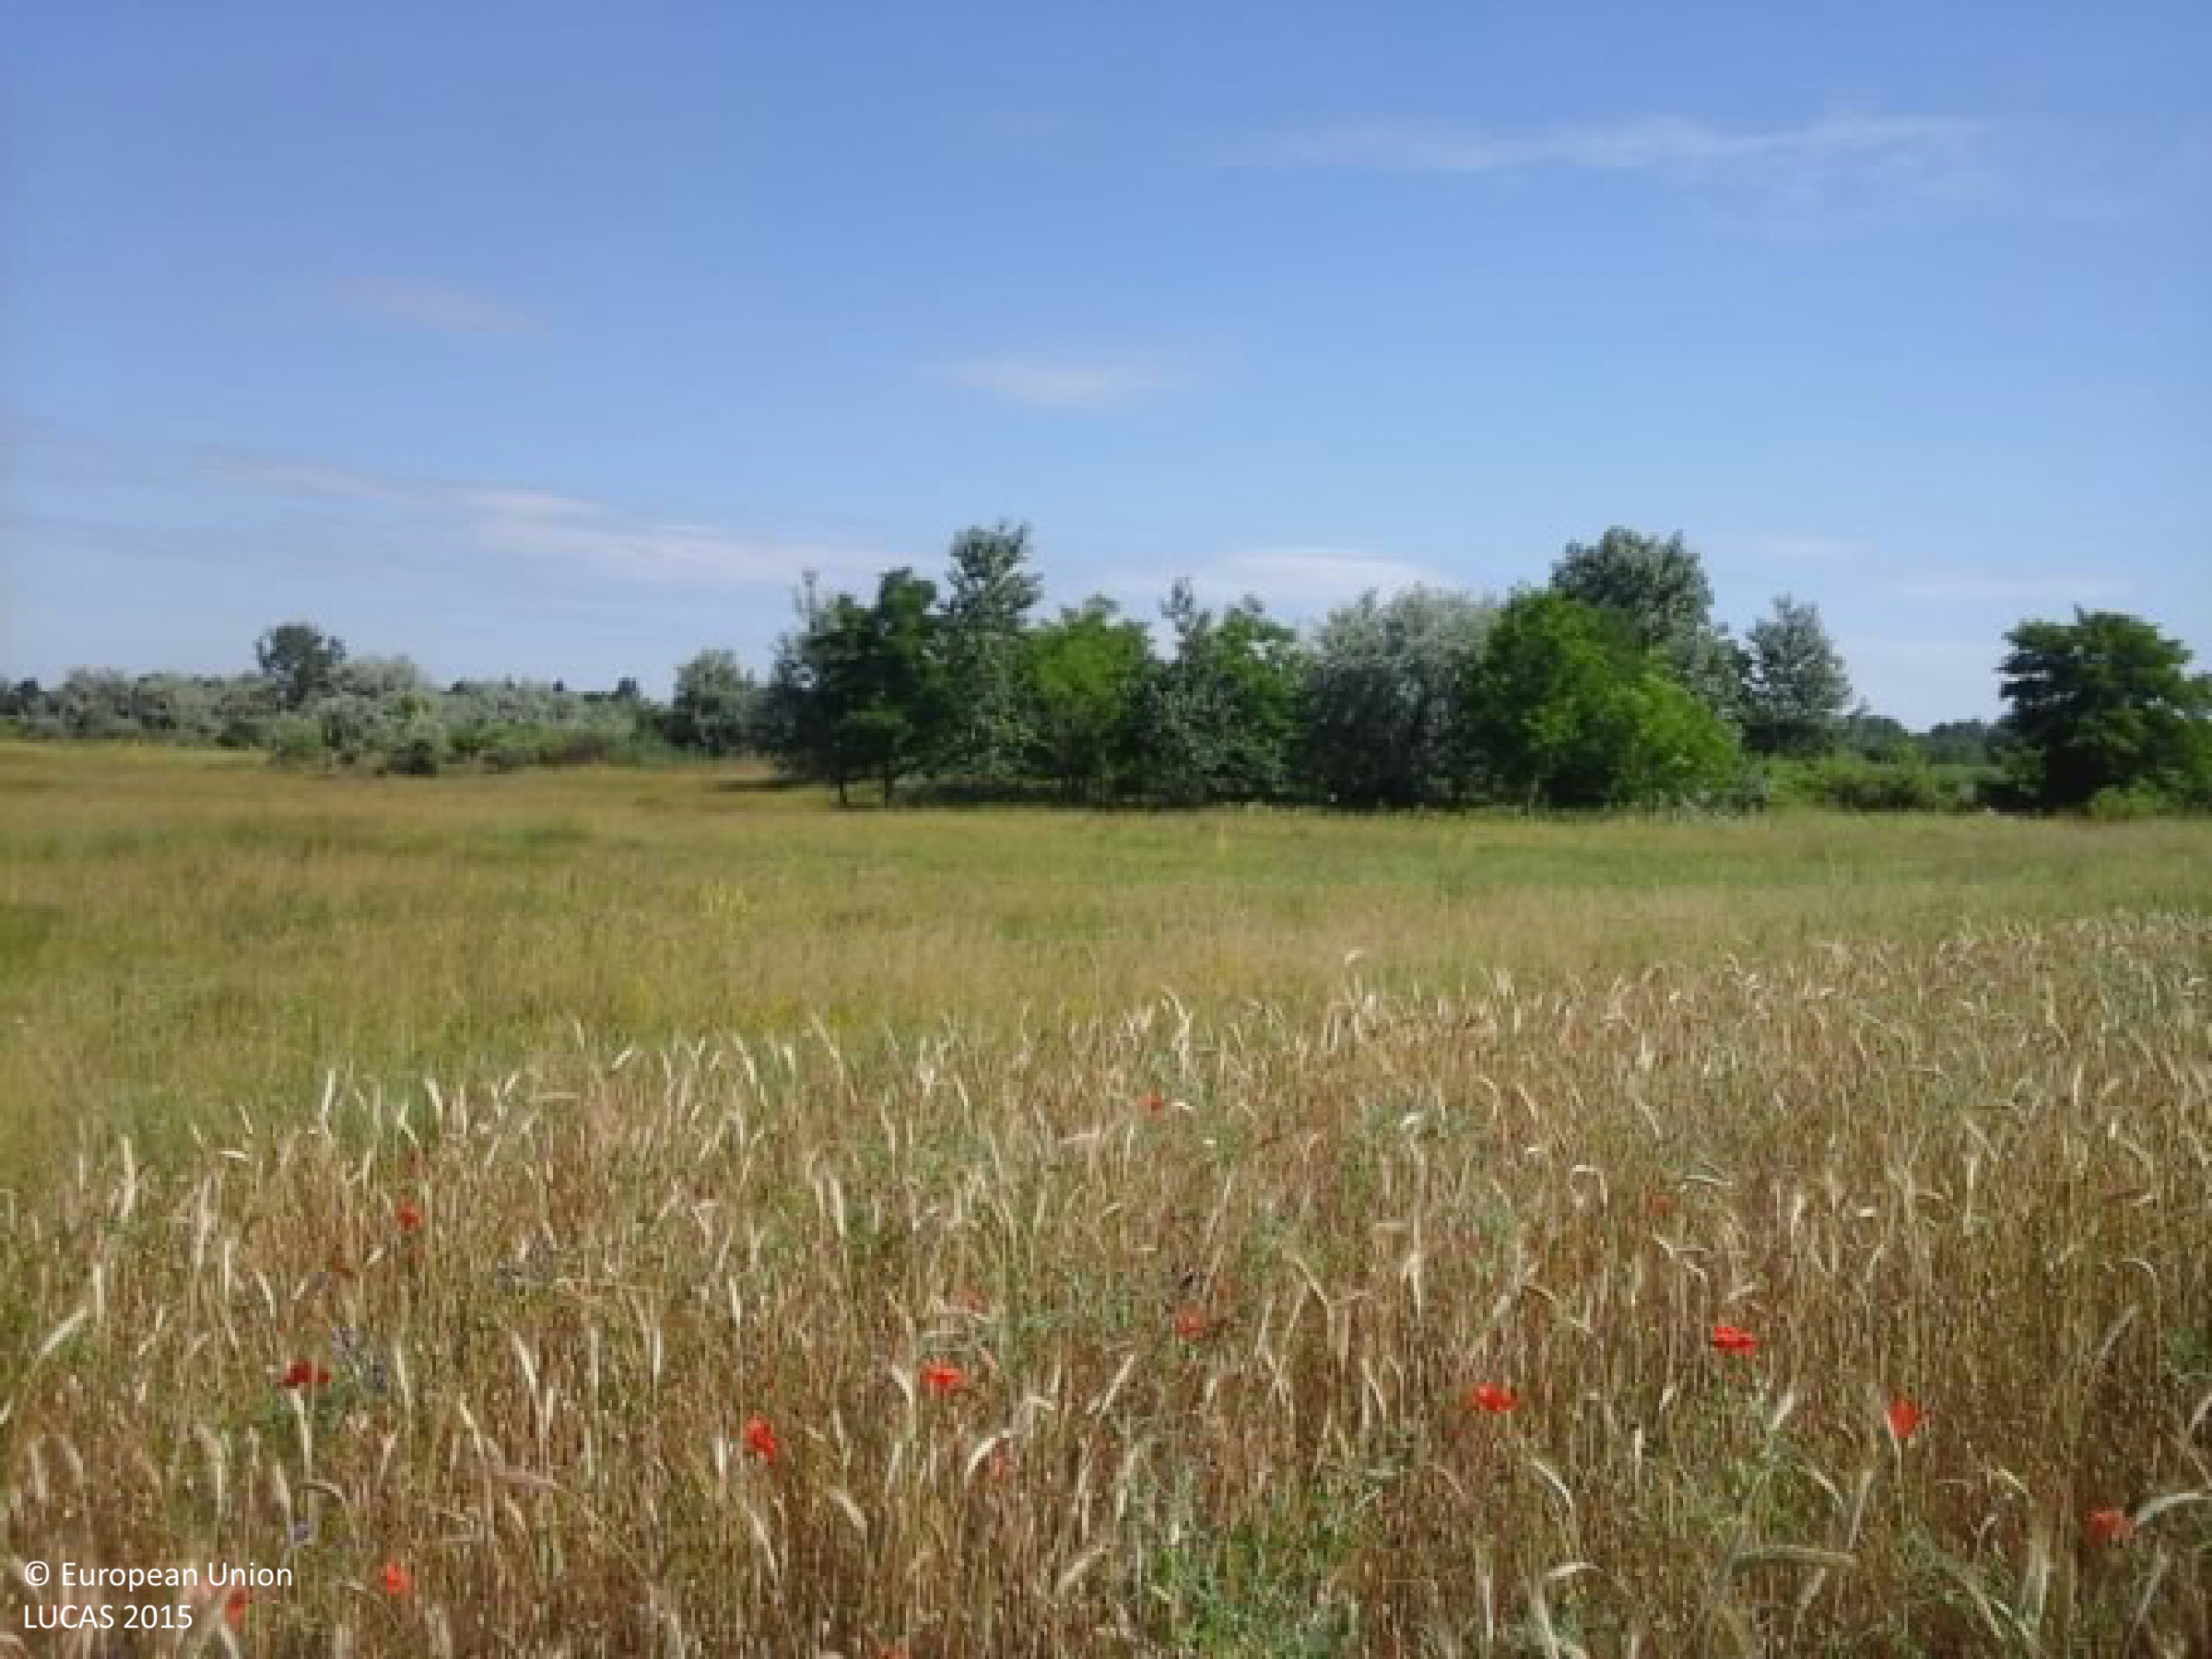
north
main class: Cropland
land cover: Common wheat
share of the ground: > 75 %
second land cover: Spontaneously vegetated surfaces
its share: 10 - 25 %
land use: Agriculture (excluding fallow land and kitchen gardens)
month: June
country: HU
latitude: 46.8807
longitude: 19.5857
